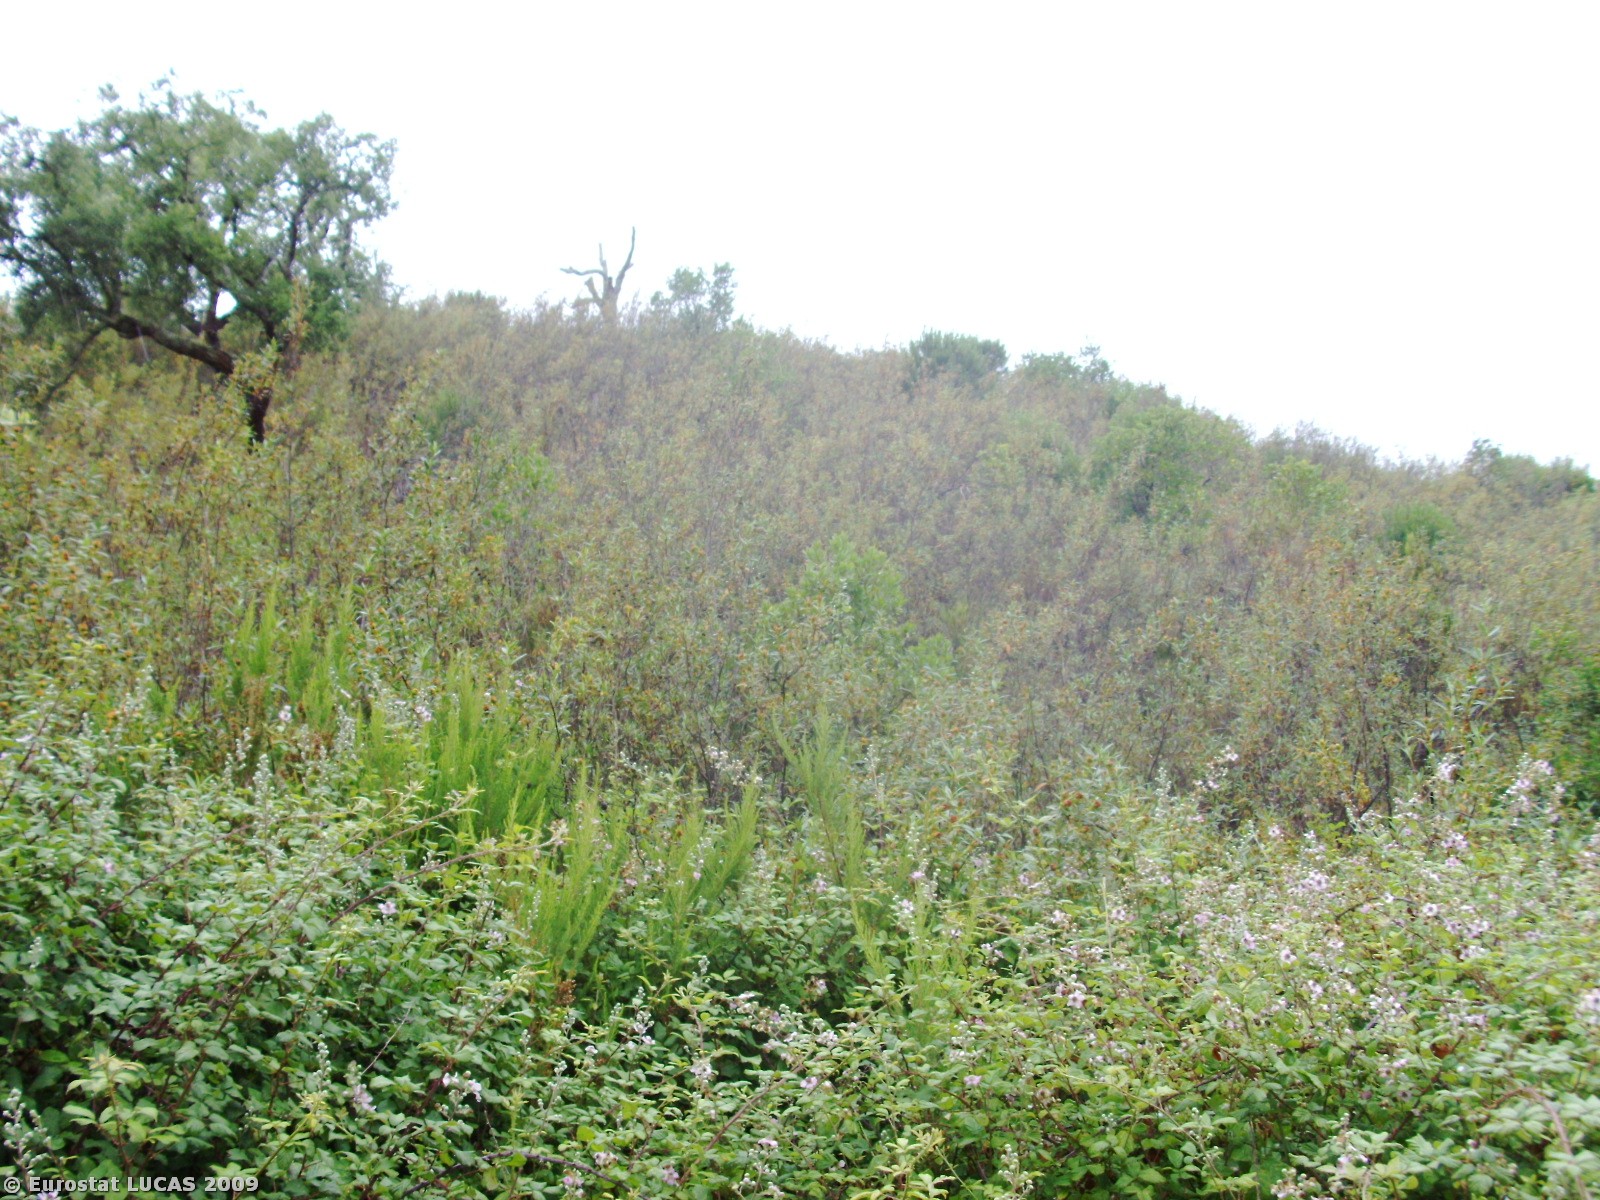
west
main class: Shrubland
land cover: Shrubland with sparse tree cover
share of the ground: > 75 %
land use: Fallow land
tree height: > 5 m
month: June
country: PT
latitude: 37.3892
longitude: -8.4507
